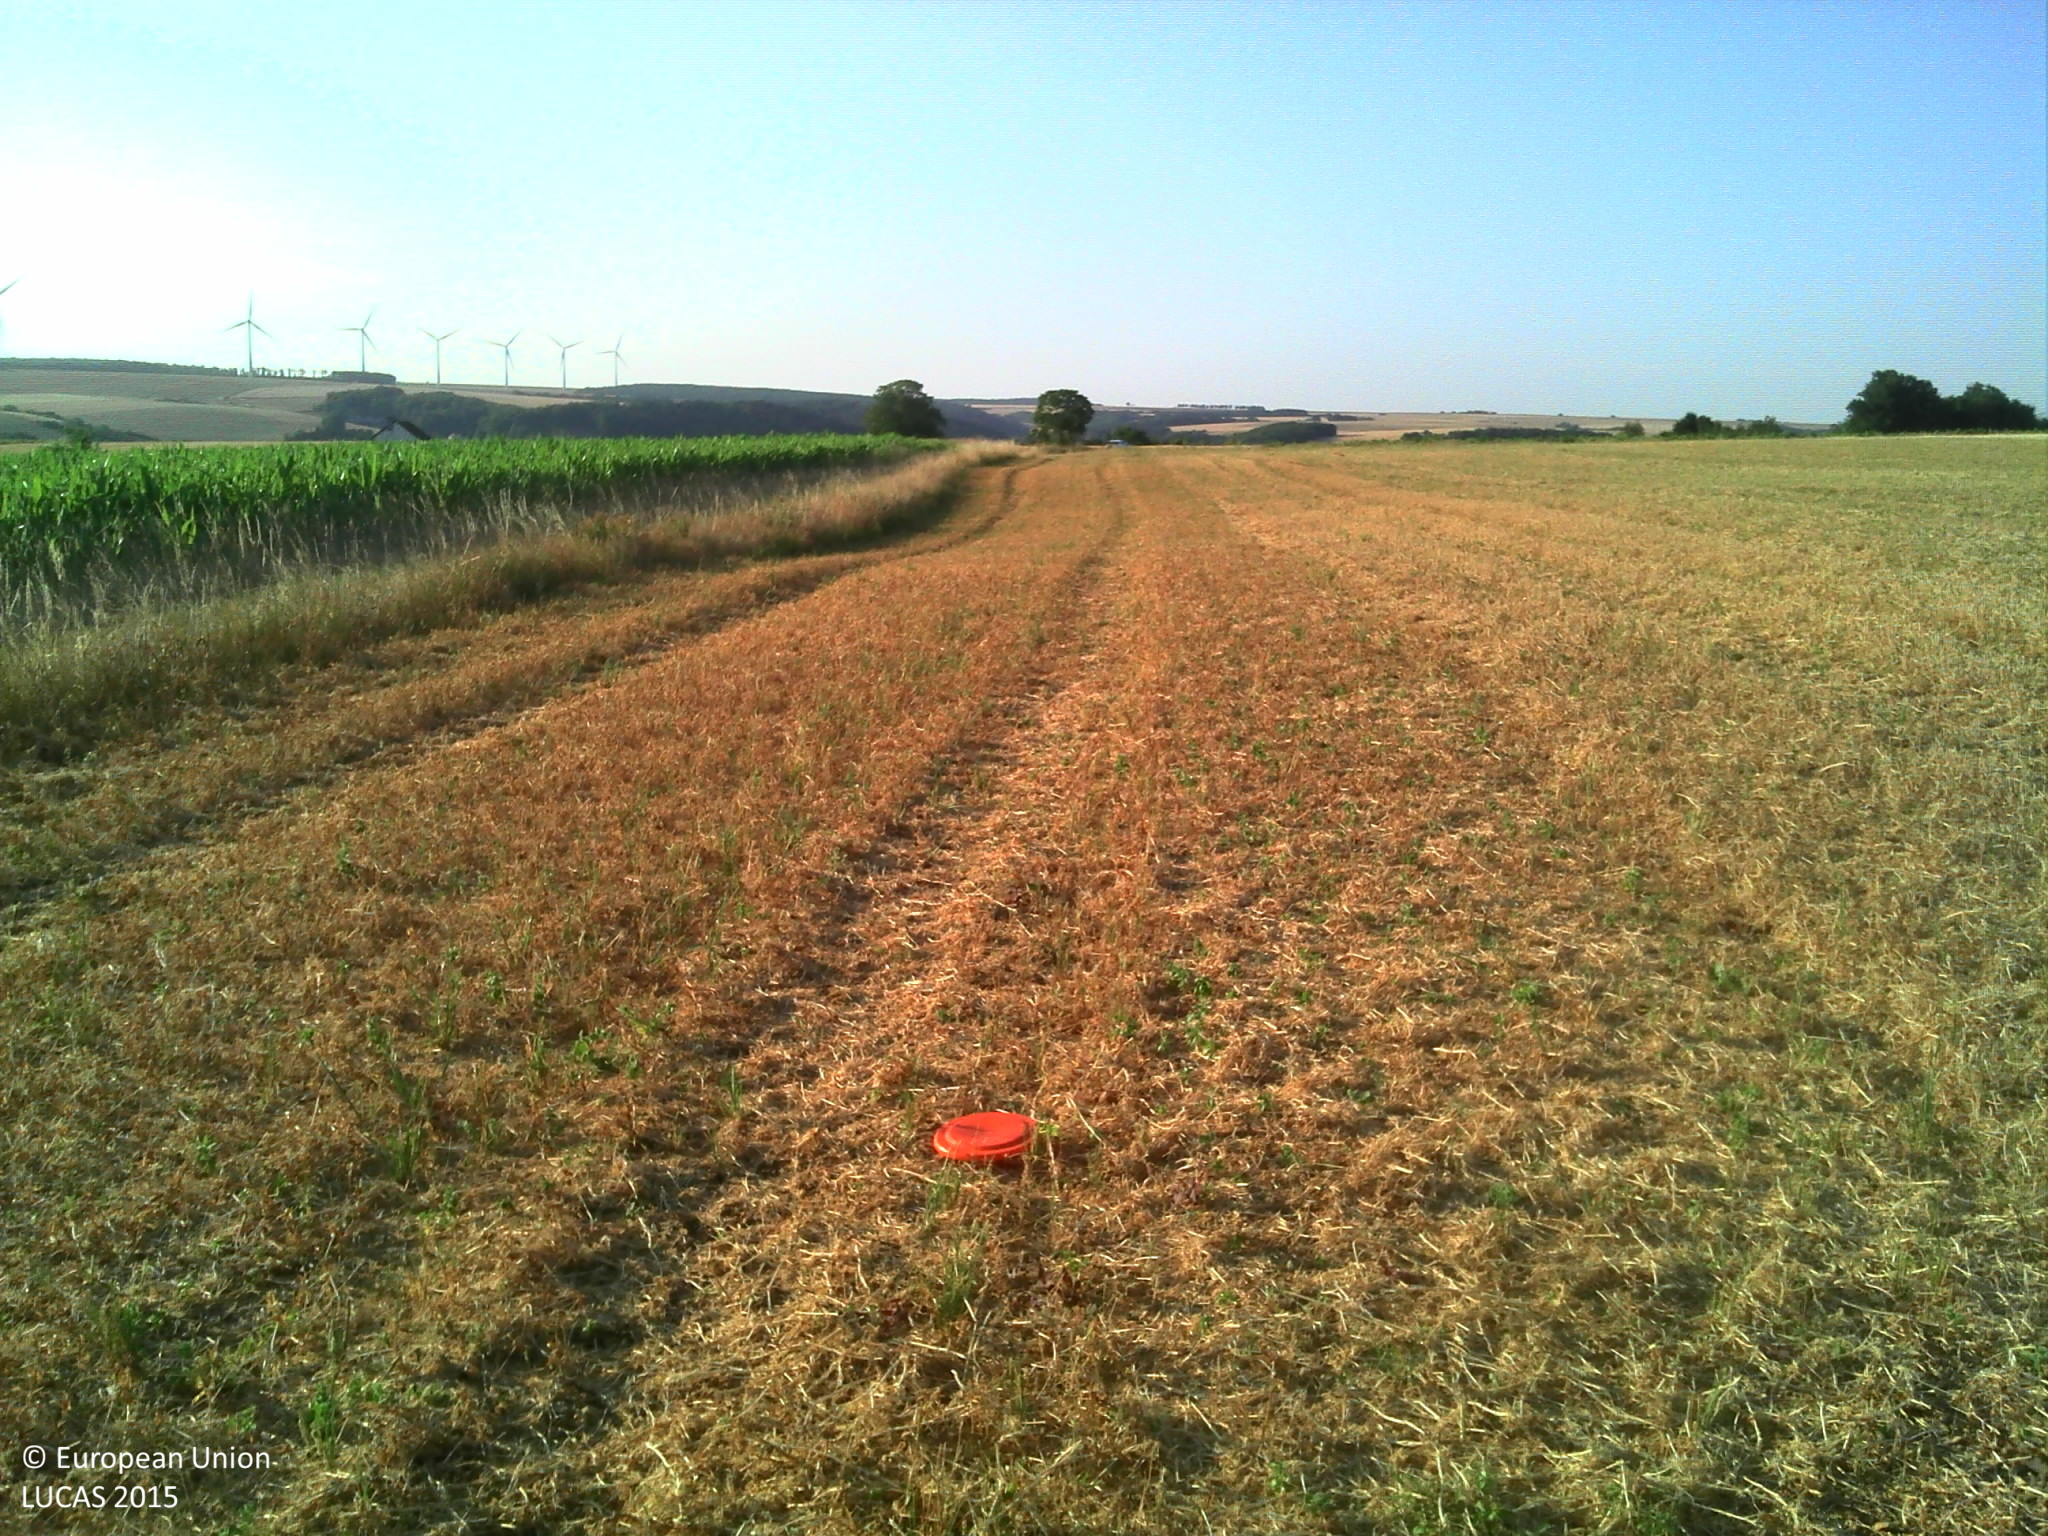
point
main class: Cropland
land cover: Dry pulses
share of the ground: > 75 %
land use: Agriculture (excluding fallow land and kitchen gardens)
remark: Harvested field
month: July
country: FR
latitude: 47.7054
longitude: 3.4786
